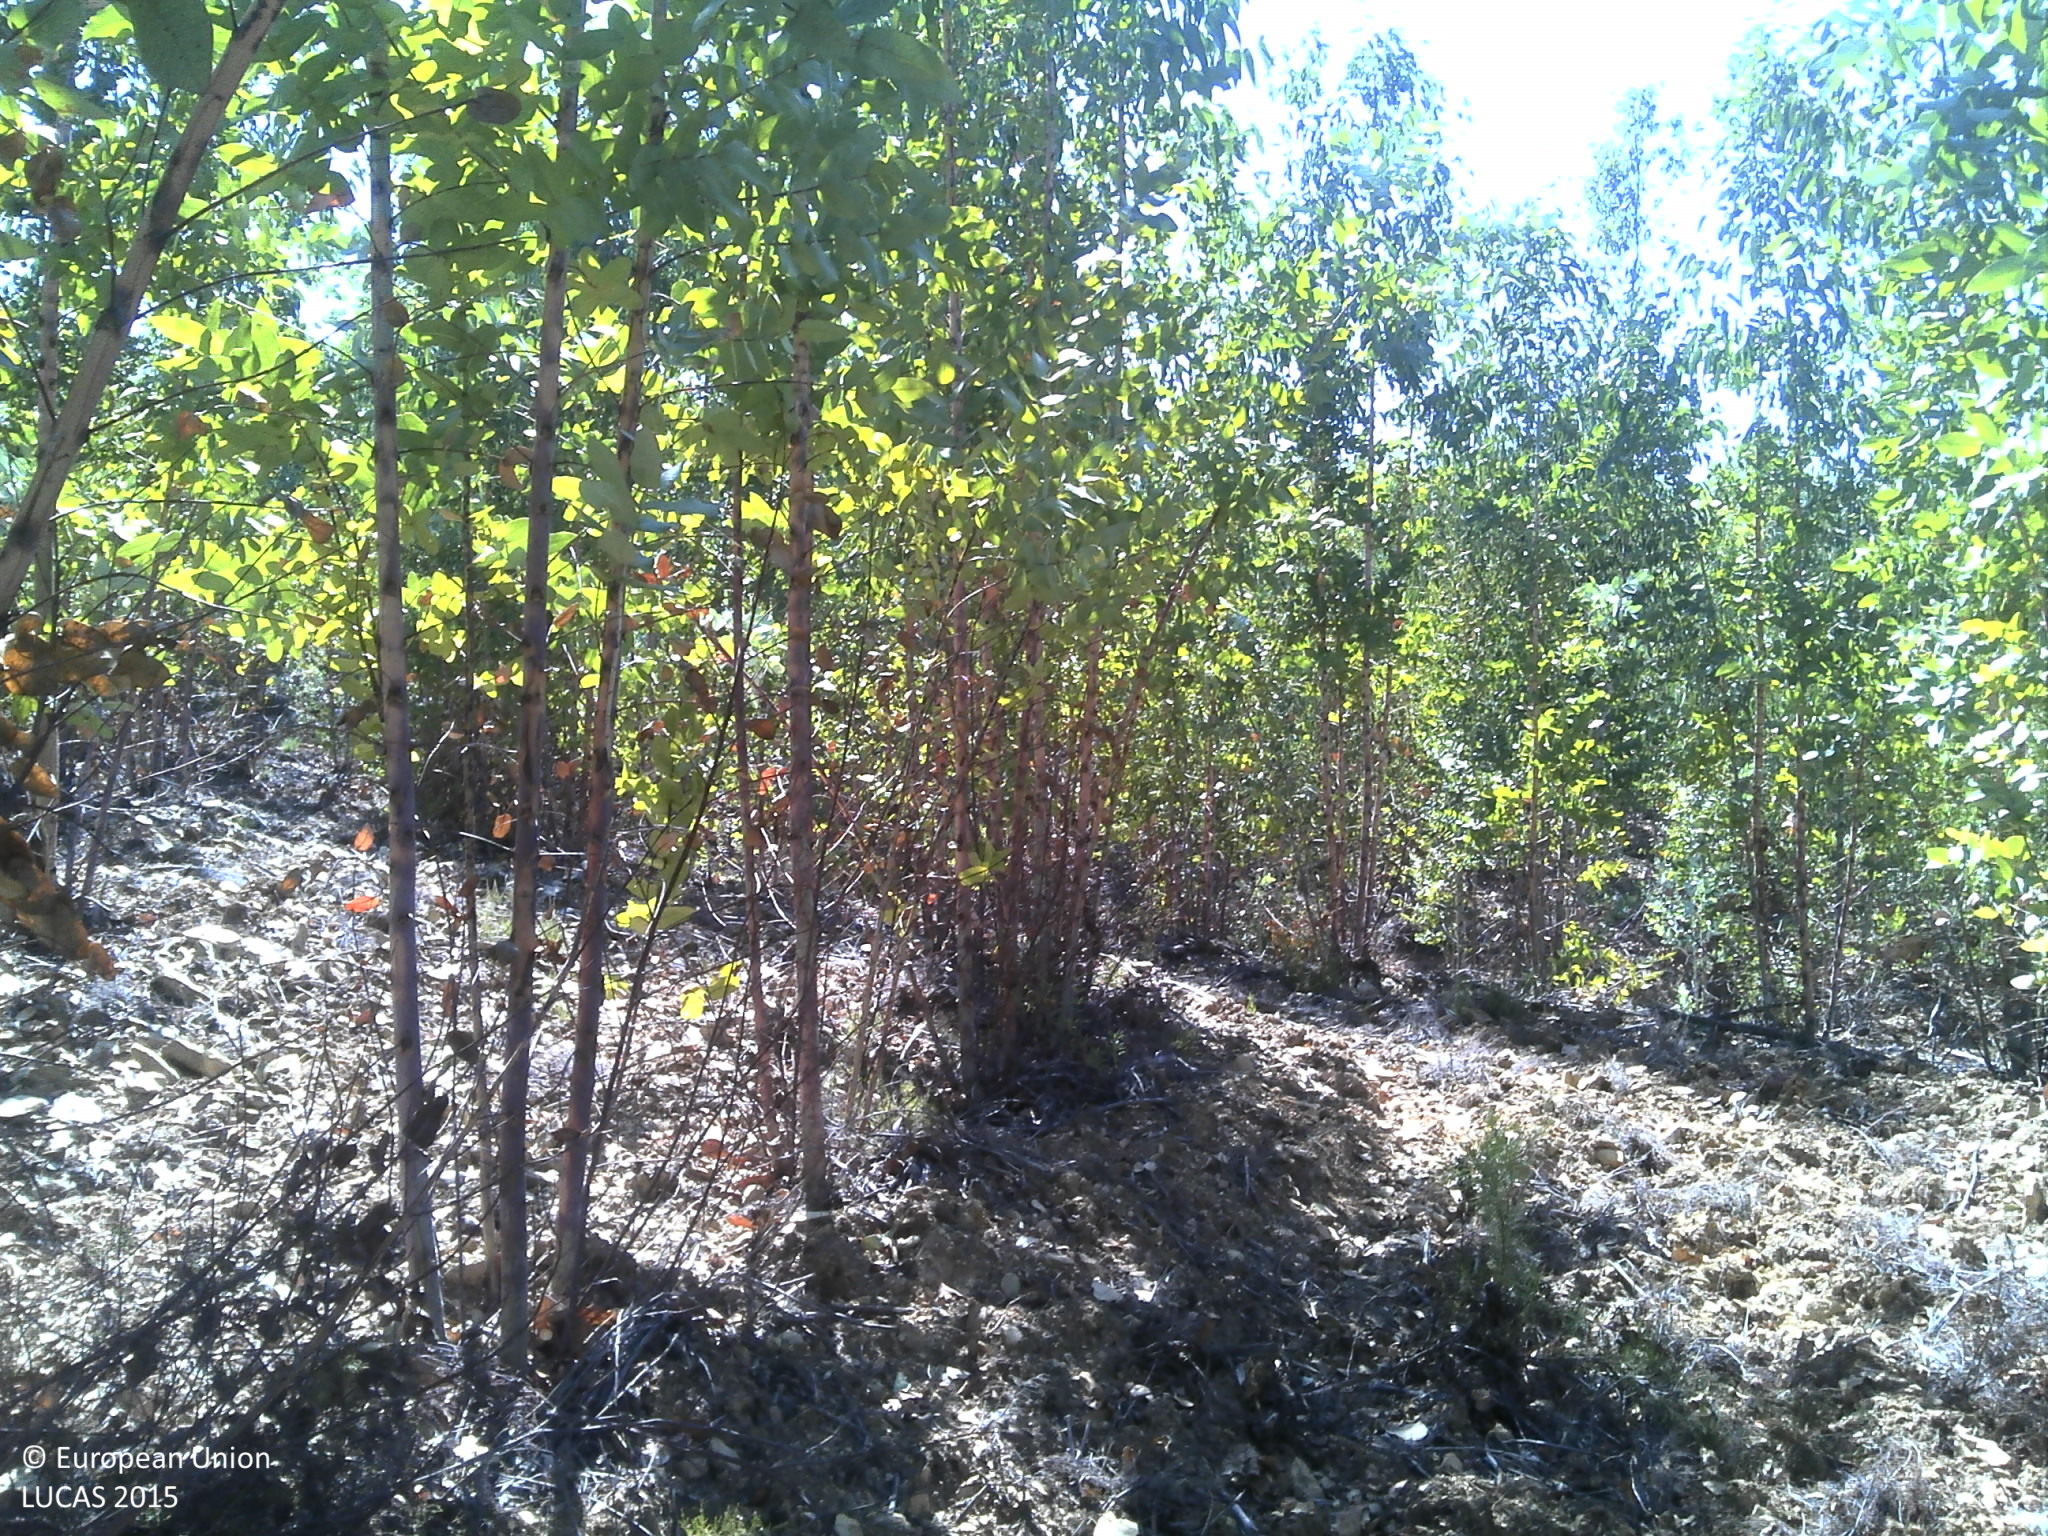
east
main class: Woodland
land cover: Broadleaved woodland
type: exotic forest
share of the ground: 25 - 50 %
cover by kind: broadleaved forest trees 50 %, unconsolidated bare surface 45 %, shrubs 5 %
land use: Forestry
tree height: > 5 m
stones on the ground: 10 - 25 %
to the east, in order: Broadleaved woodland; Electric lines; Broadleaved woodland; Tracks; Broadleaved woodland; Tracks; Broadleaved woodland
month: July
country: PT
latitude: 40.0283
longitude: -7.6005
